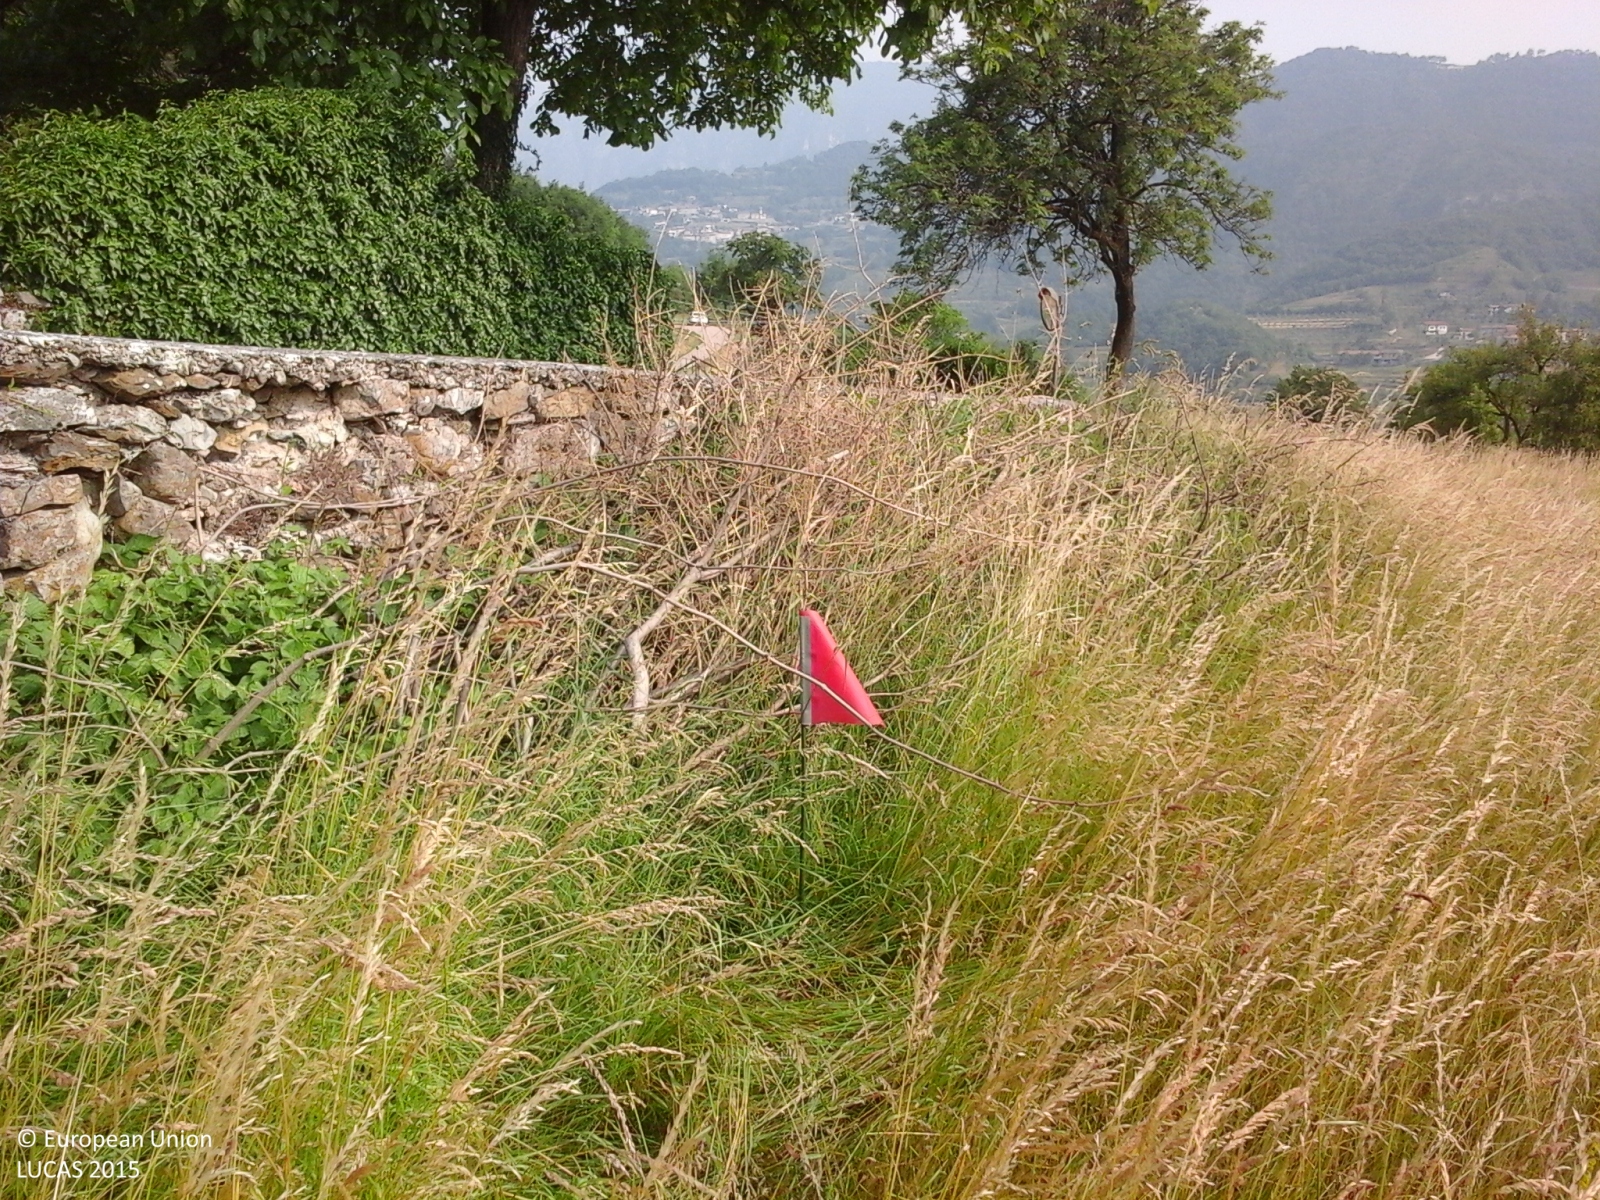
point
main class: Grassland
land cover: Grassland without tree/shrub cover
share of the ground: > 75 %
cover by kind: herbaceous plants 100 %
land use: Agriculture (excluding fallow land and kitchen gardens)
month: June
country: IT
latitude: 45.7542
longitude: 10.7316
